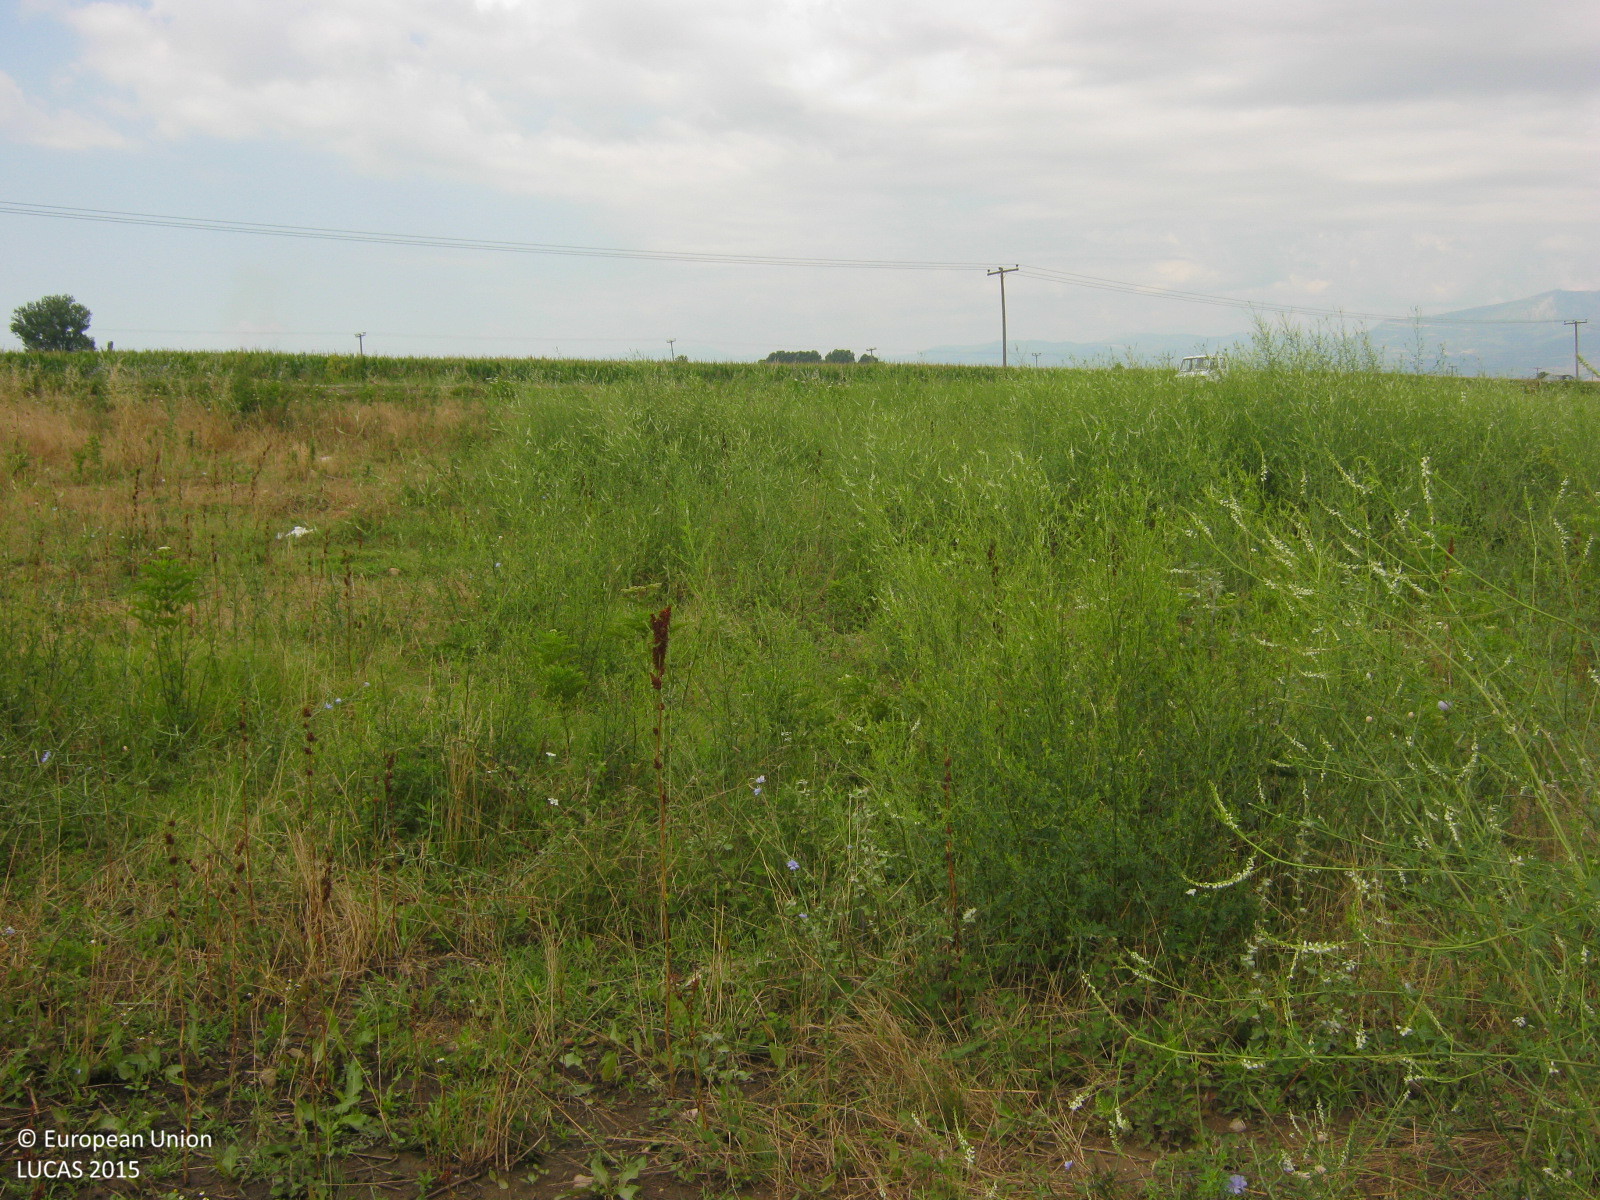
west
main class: Grassland
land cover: Spontaneously vegetated surfaces
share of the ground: > 75 %
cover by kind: herbaceous plants 100 %
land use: Abandoned areas
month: June
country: GR
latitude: 41.0743
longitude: 24.9790
